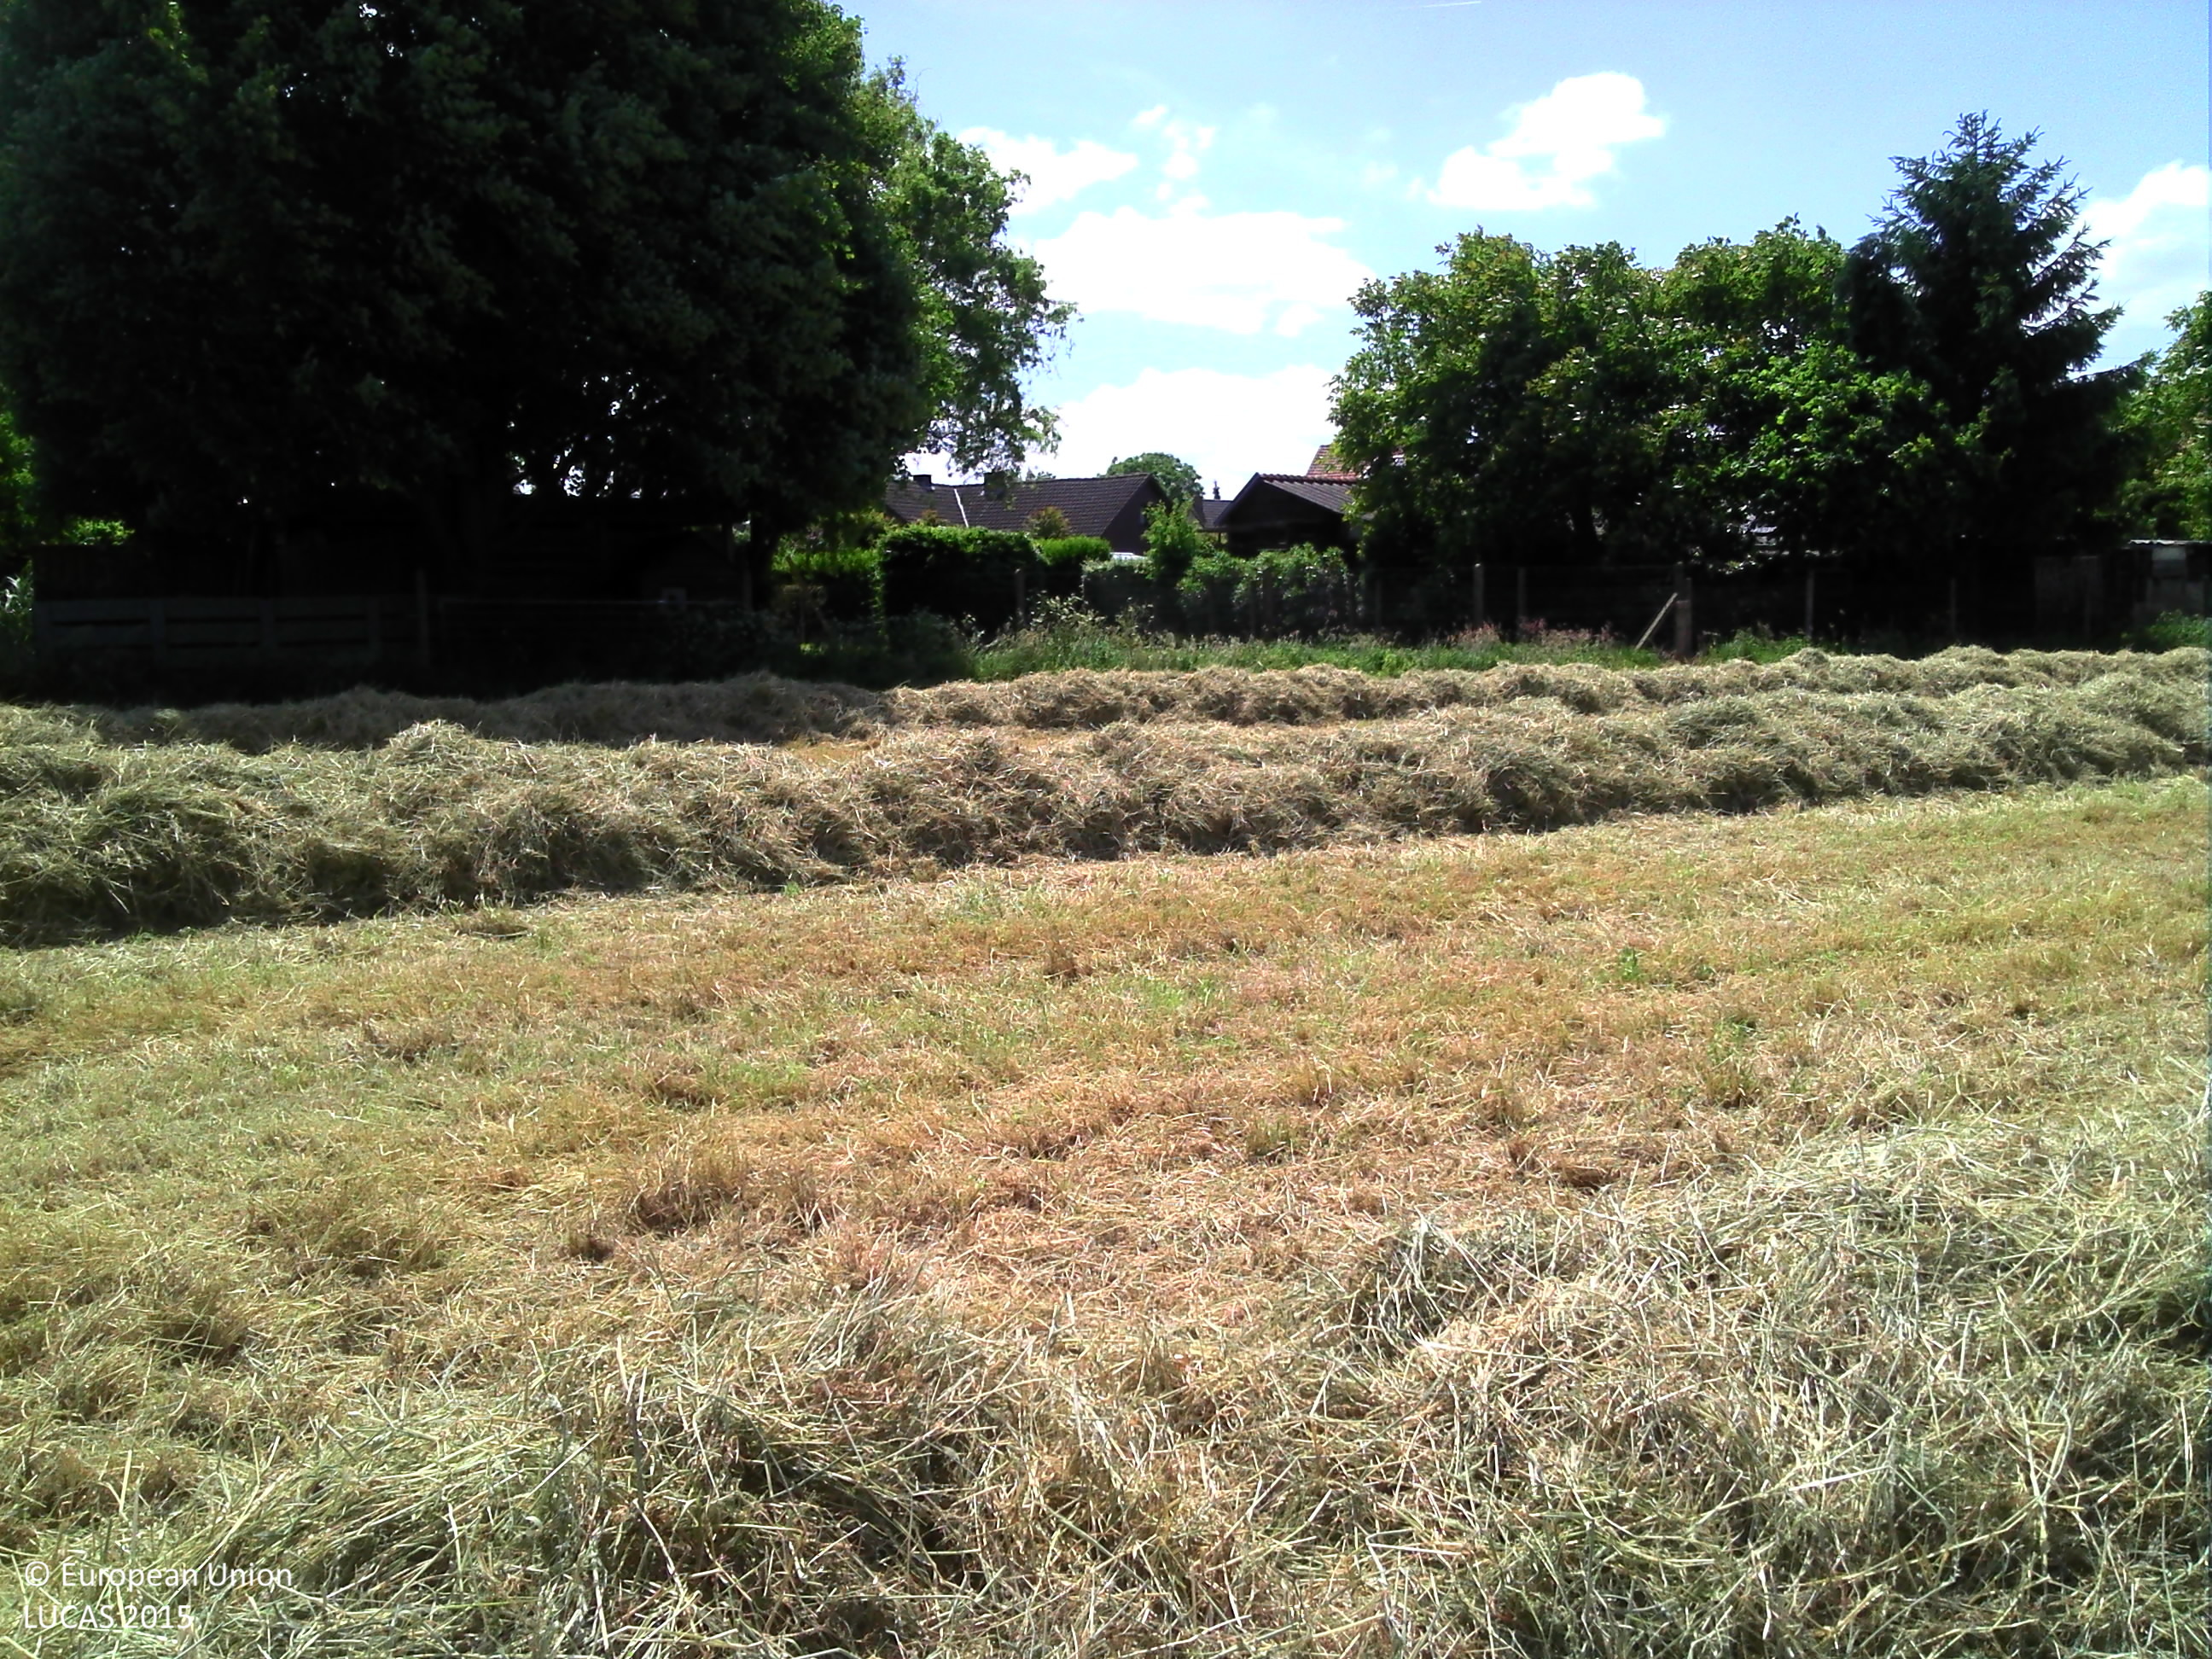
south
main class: Grassland
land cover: Grassland without tree/shrub cover
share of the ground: > 75 %
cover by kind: herbaceous plants 100 %
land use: Agriculture (excluding fallow land and kitchen gardens)
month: June
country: BE
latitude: 51.1484
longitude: 5.7242
